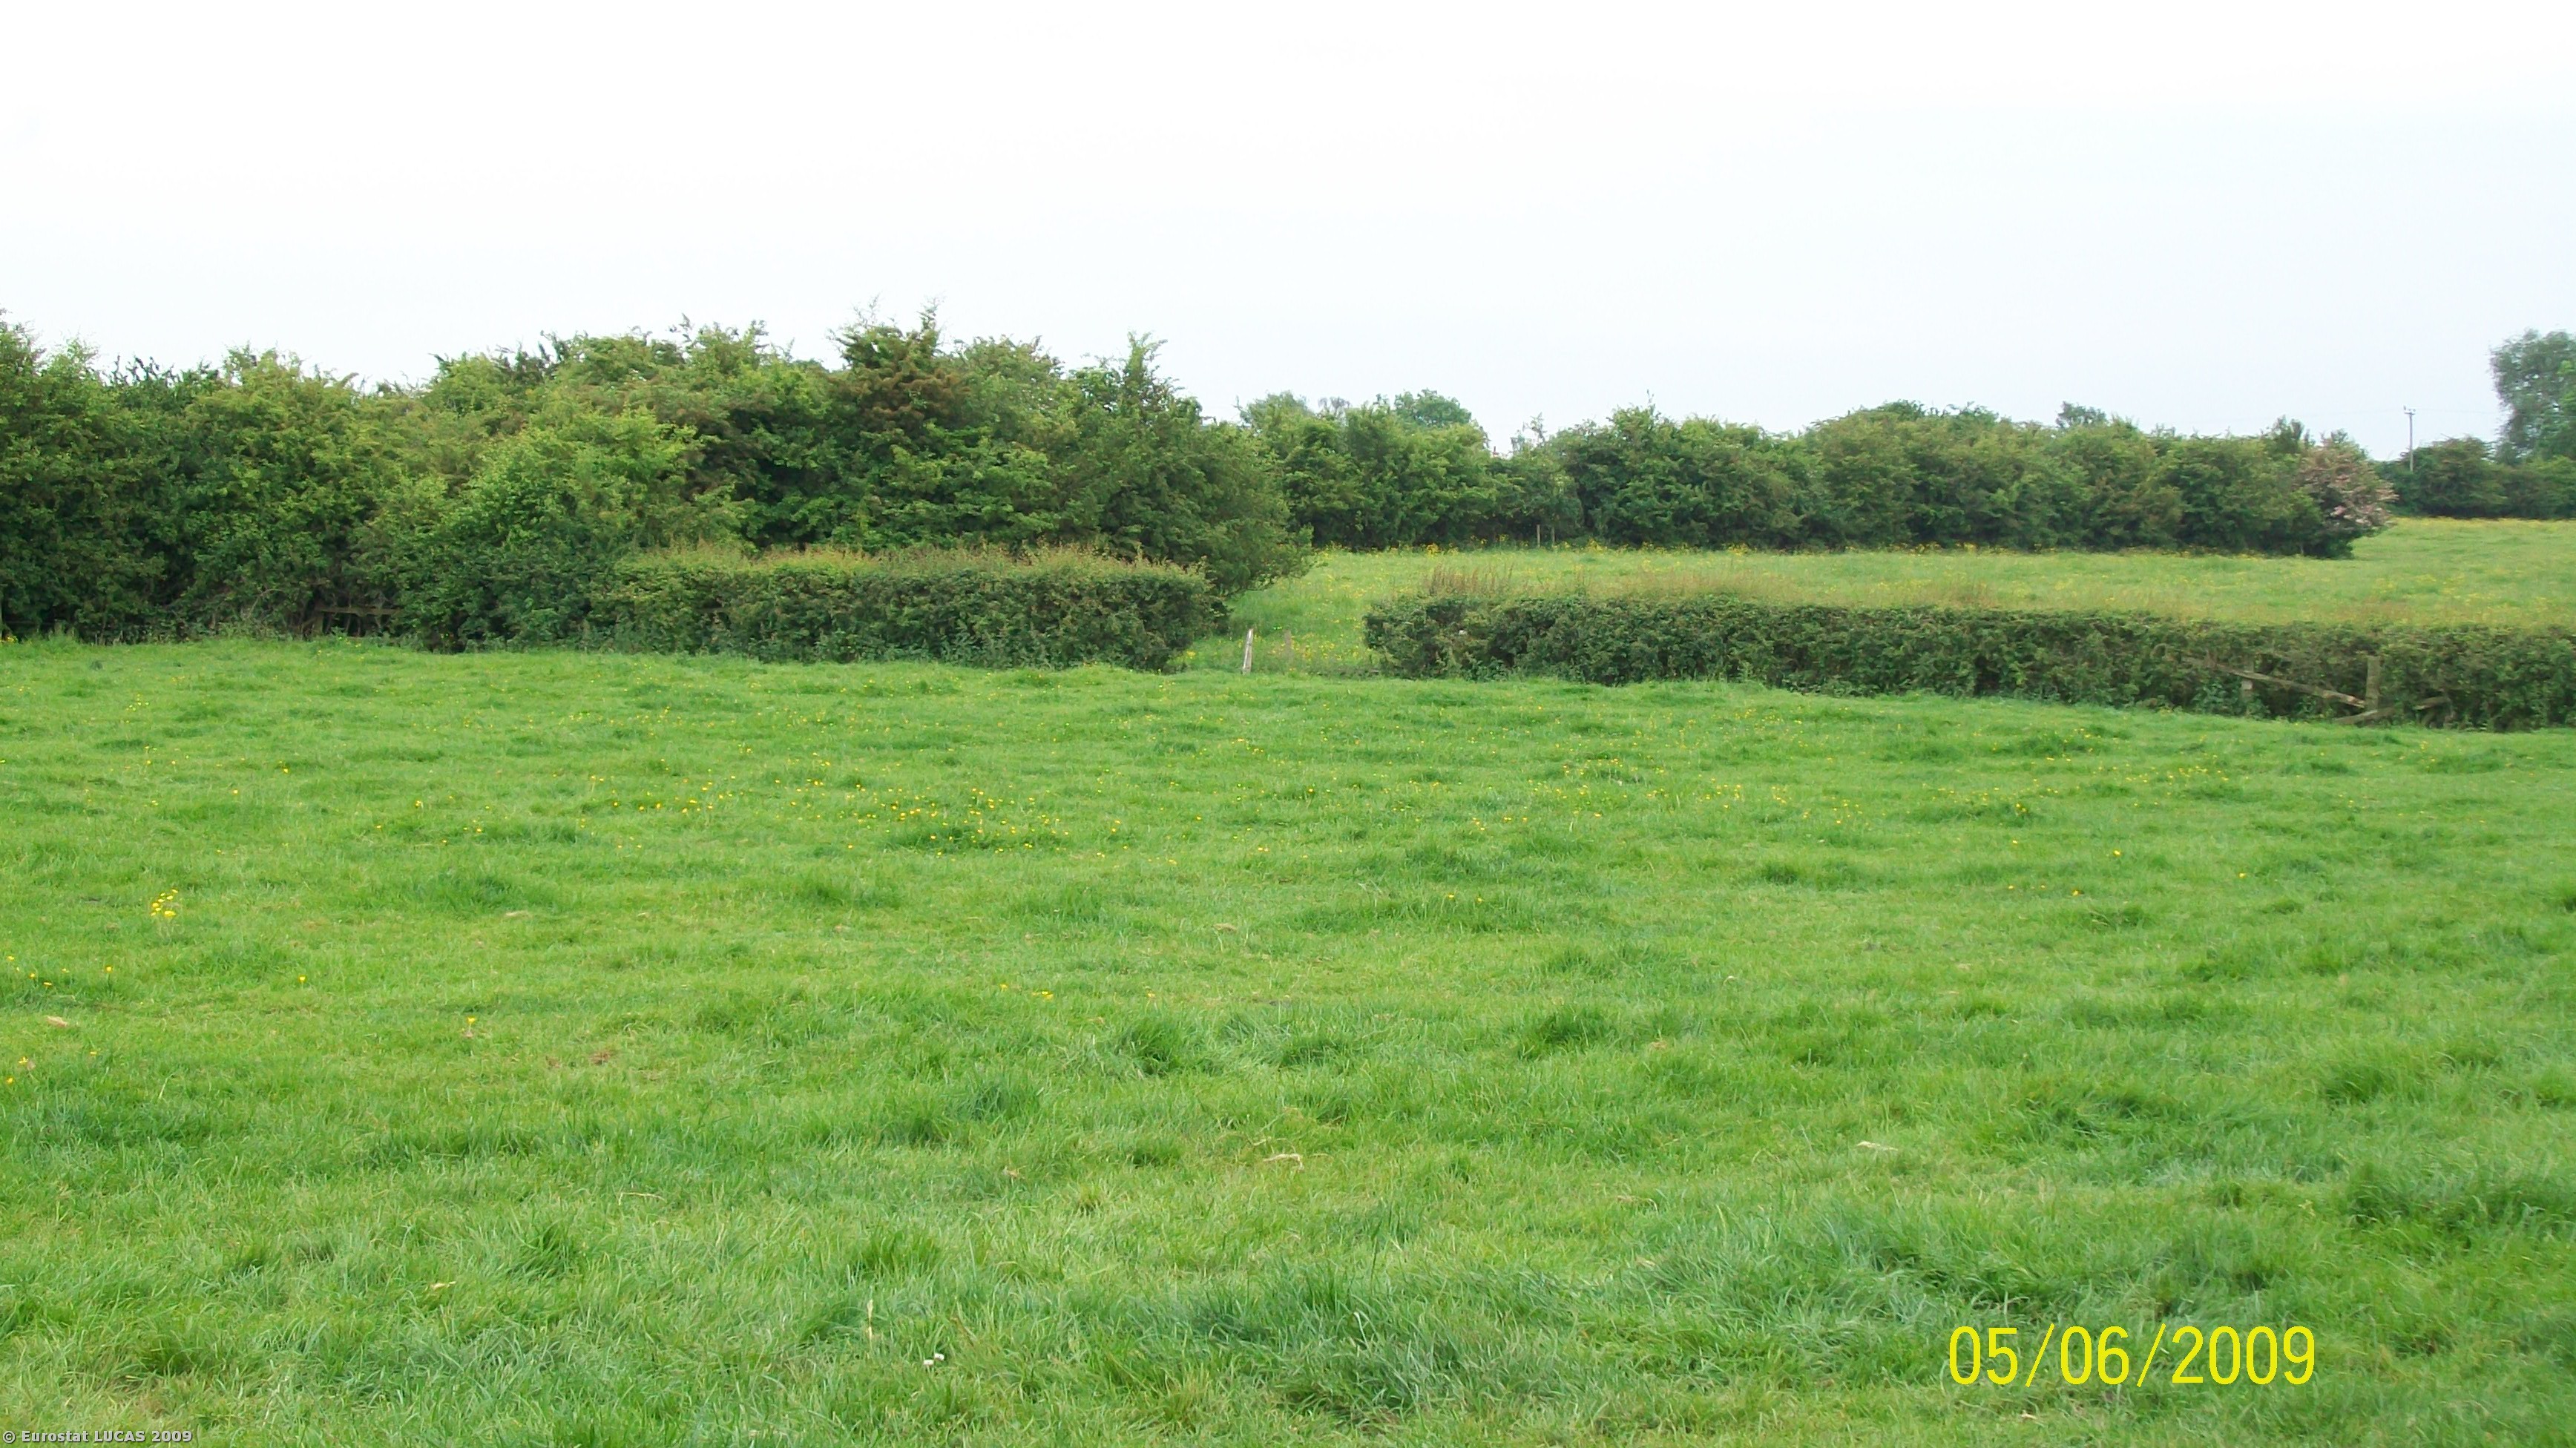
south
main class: Grassland
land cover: Grassland without tree/shrub cover
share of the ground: > 75 %
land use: Agriculture (excluding fallow land and kitchen gardens)
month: June
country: GB
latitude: 53.1596
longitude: -2.7679
